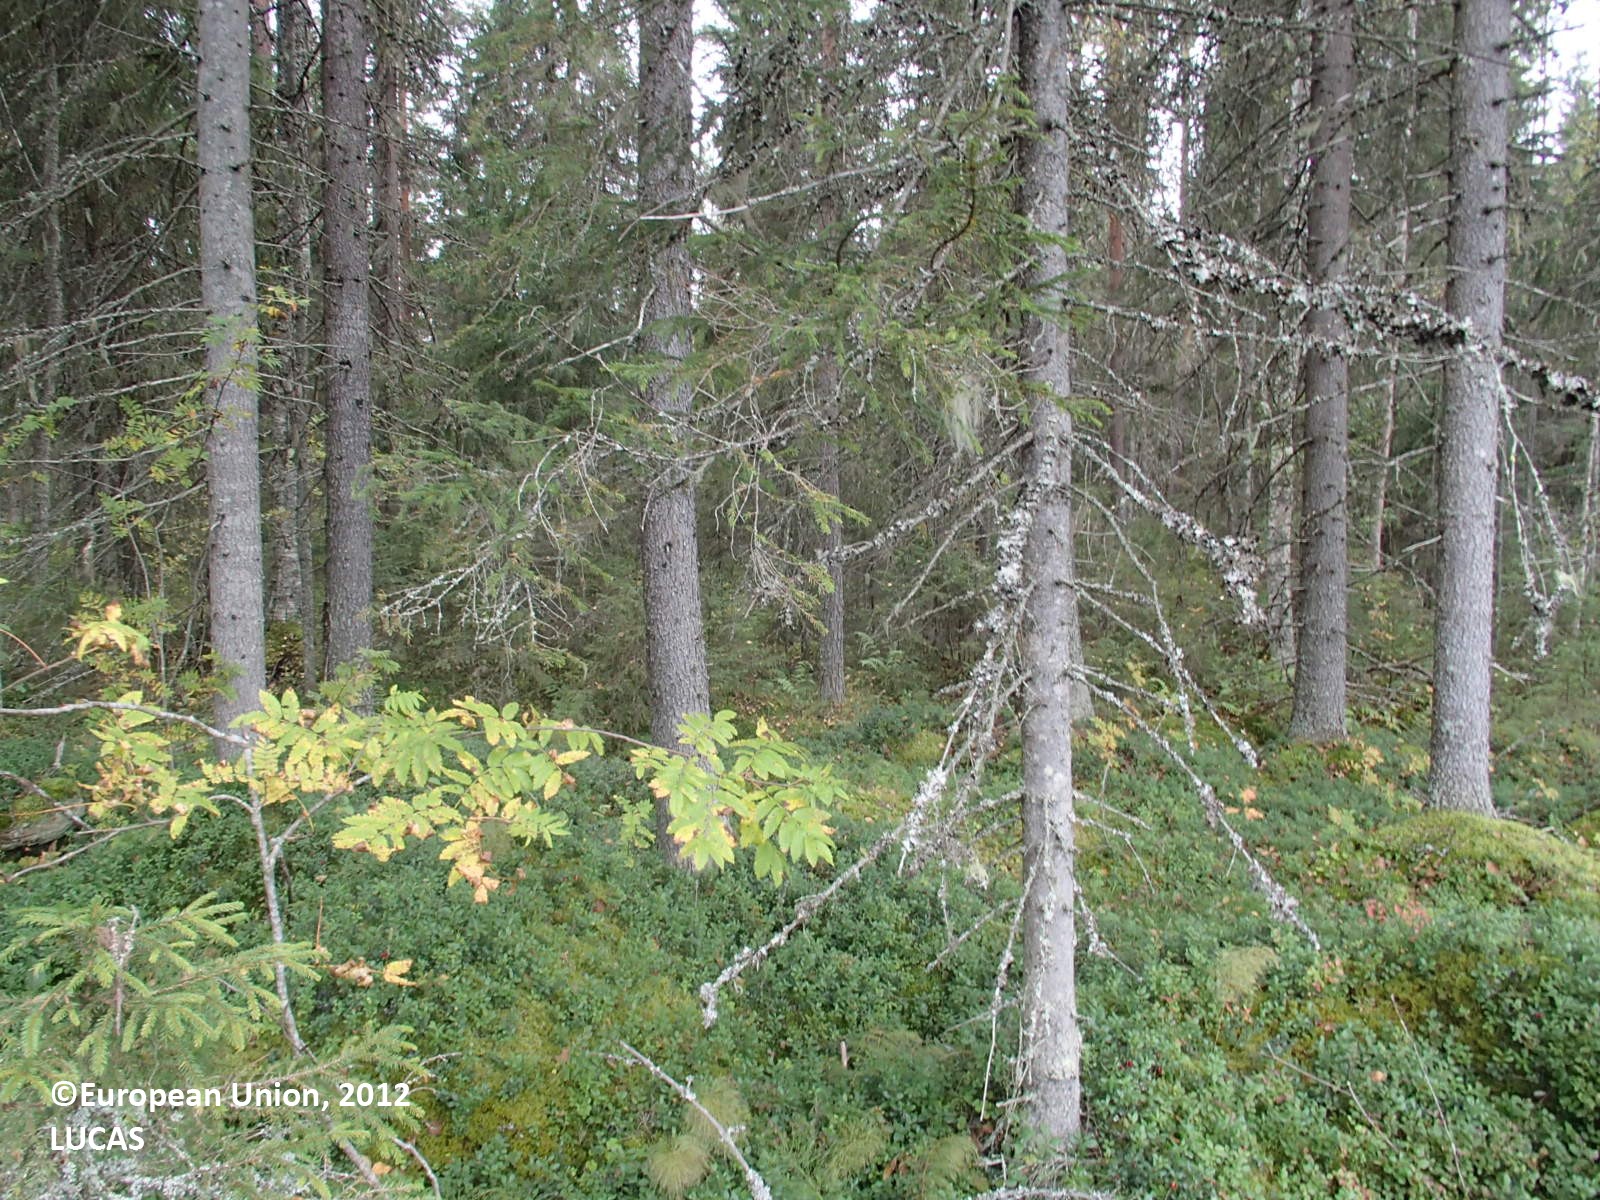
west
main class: Woodland
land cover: Spruce dominated mixed woodland
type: boreal forest
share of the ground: 50 - 75 %
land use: Forestry
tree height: > 5 m
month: September
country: FI
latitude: 63.8206
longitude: 27.1873
